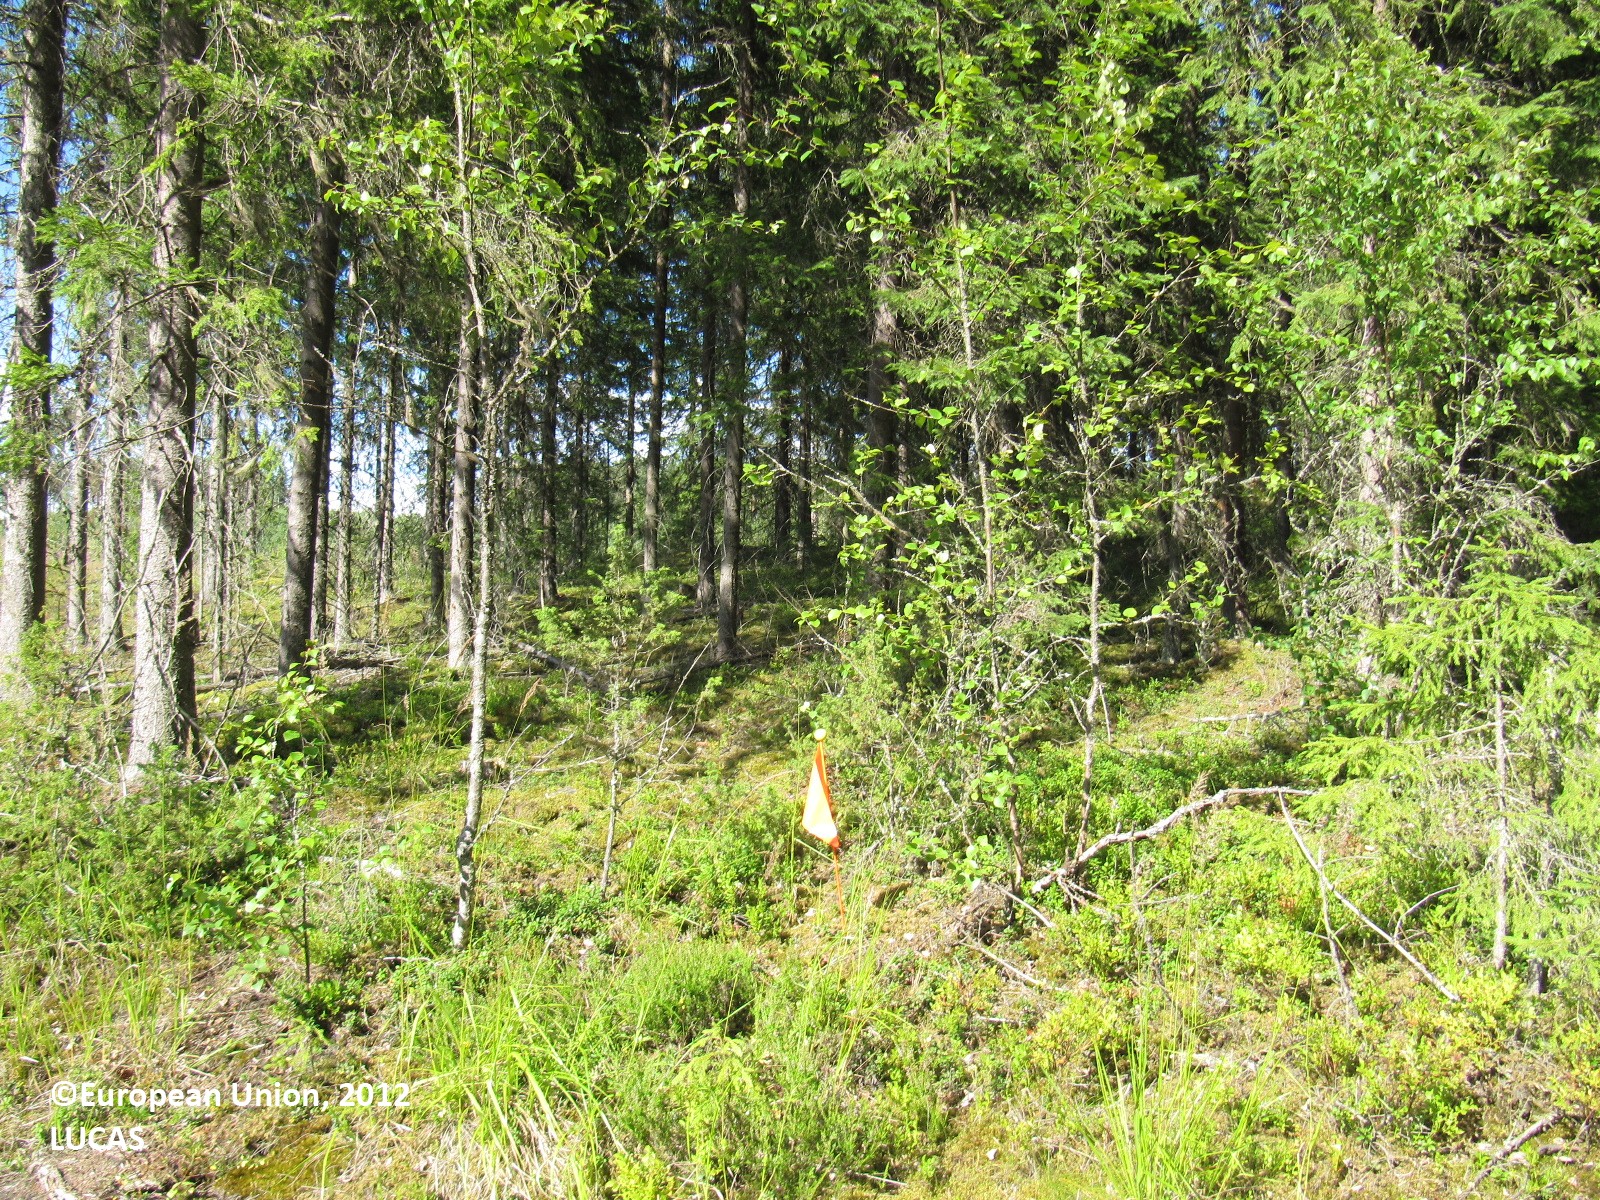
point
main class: Woodland
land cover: Spruce dominated coniferous woodland
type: boreal forest
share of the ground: 50 - 75 %
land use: Forestry
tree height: > 5 m
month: July
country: FI
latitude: 60.8492
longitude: 24.4013
